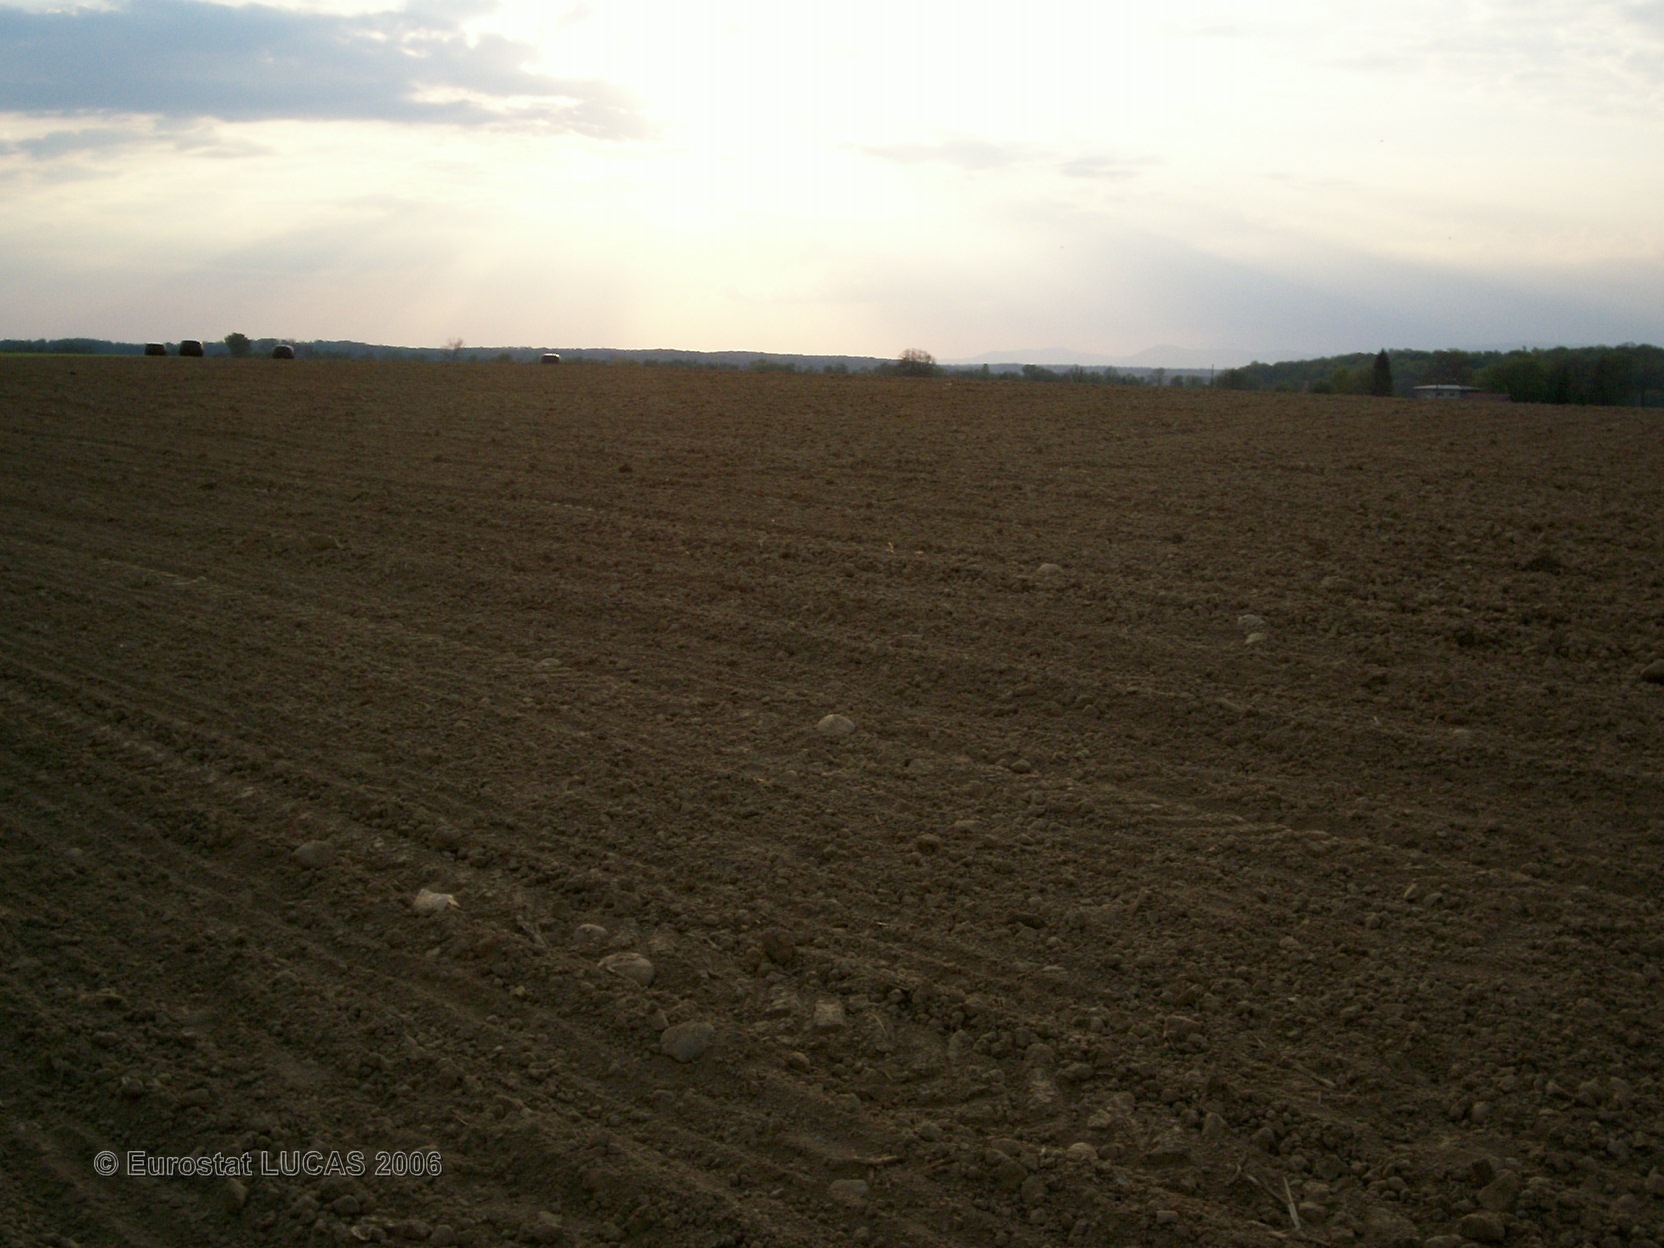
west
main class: Cropland
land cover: Maize
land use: Agriculture (excluding fallow land and kitchen gardens)
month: May
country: FR
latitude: 47.6462
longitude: 7.1395
